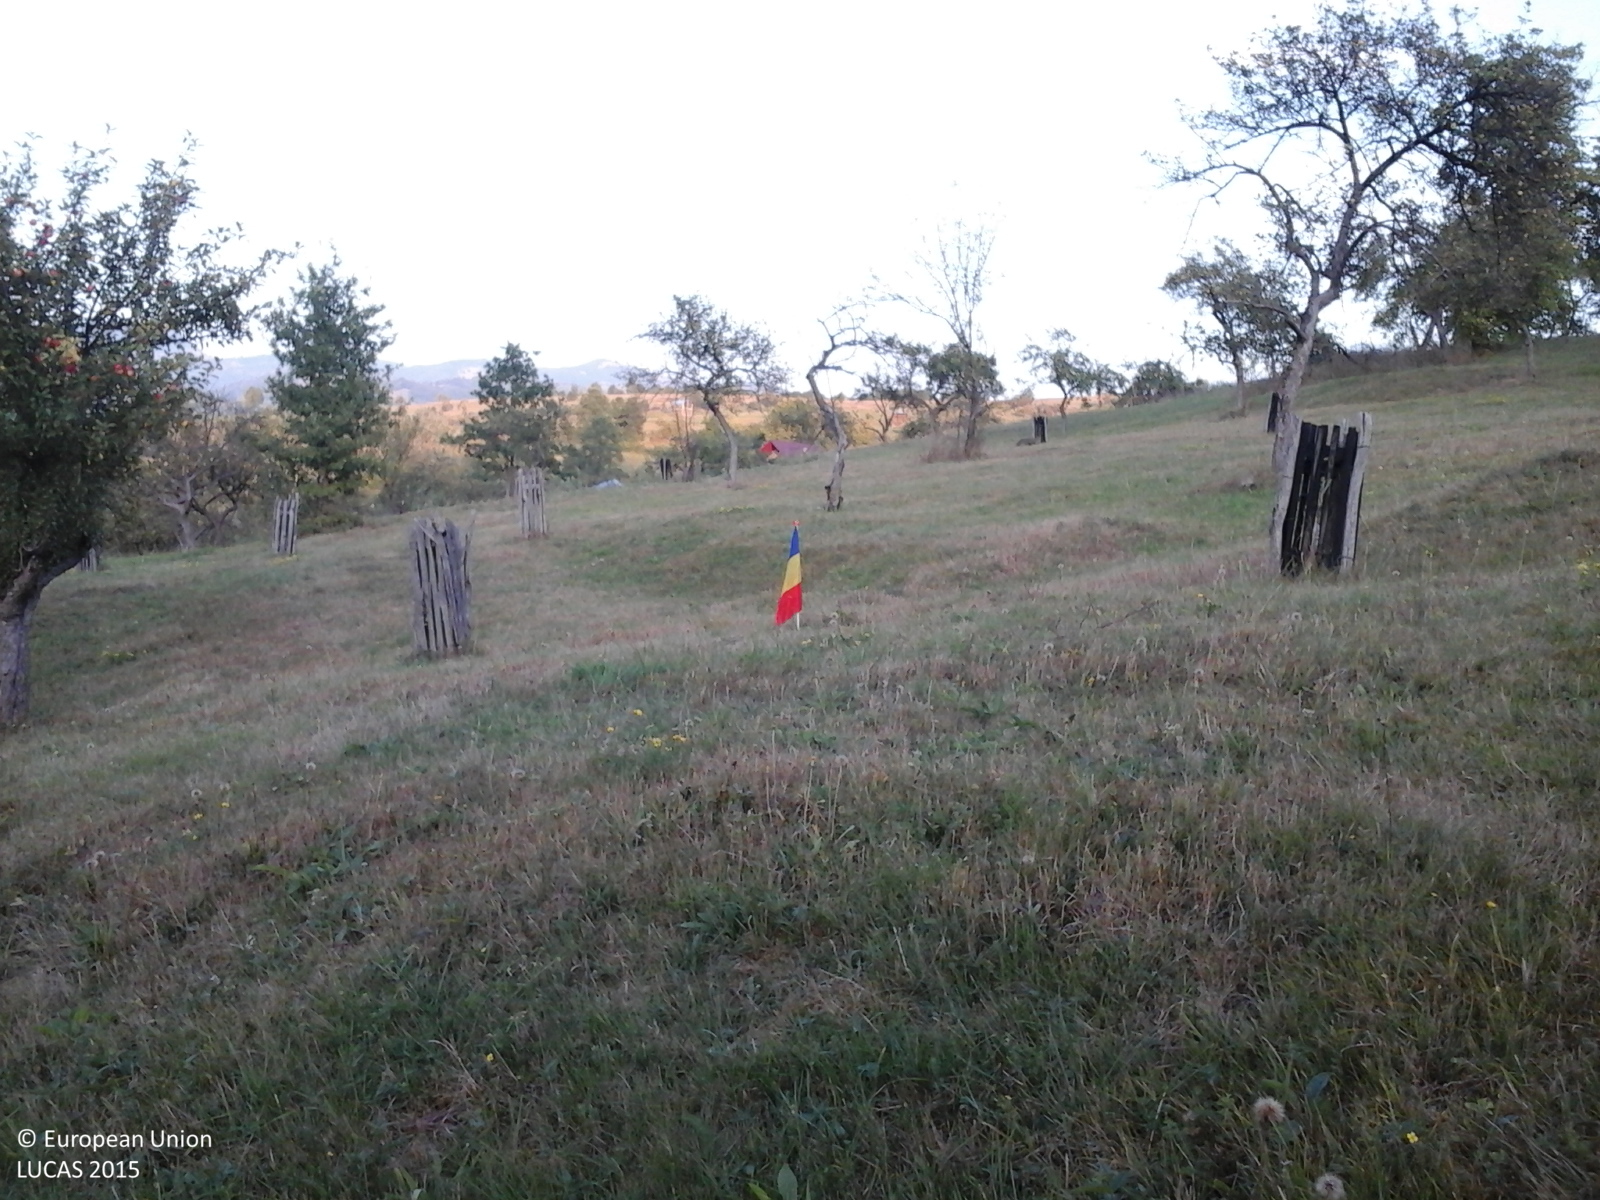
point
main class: Cropland
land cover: Apple fruit
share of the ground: 25 - 50 %
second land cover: Grassland without tree/shrub cover
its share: > 75 %
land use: Agriculture (excluding fallow land and kitchen gardens)
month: September
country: RO
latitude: 47.8305
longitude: 24.1826
